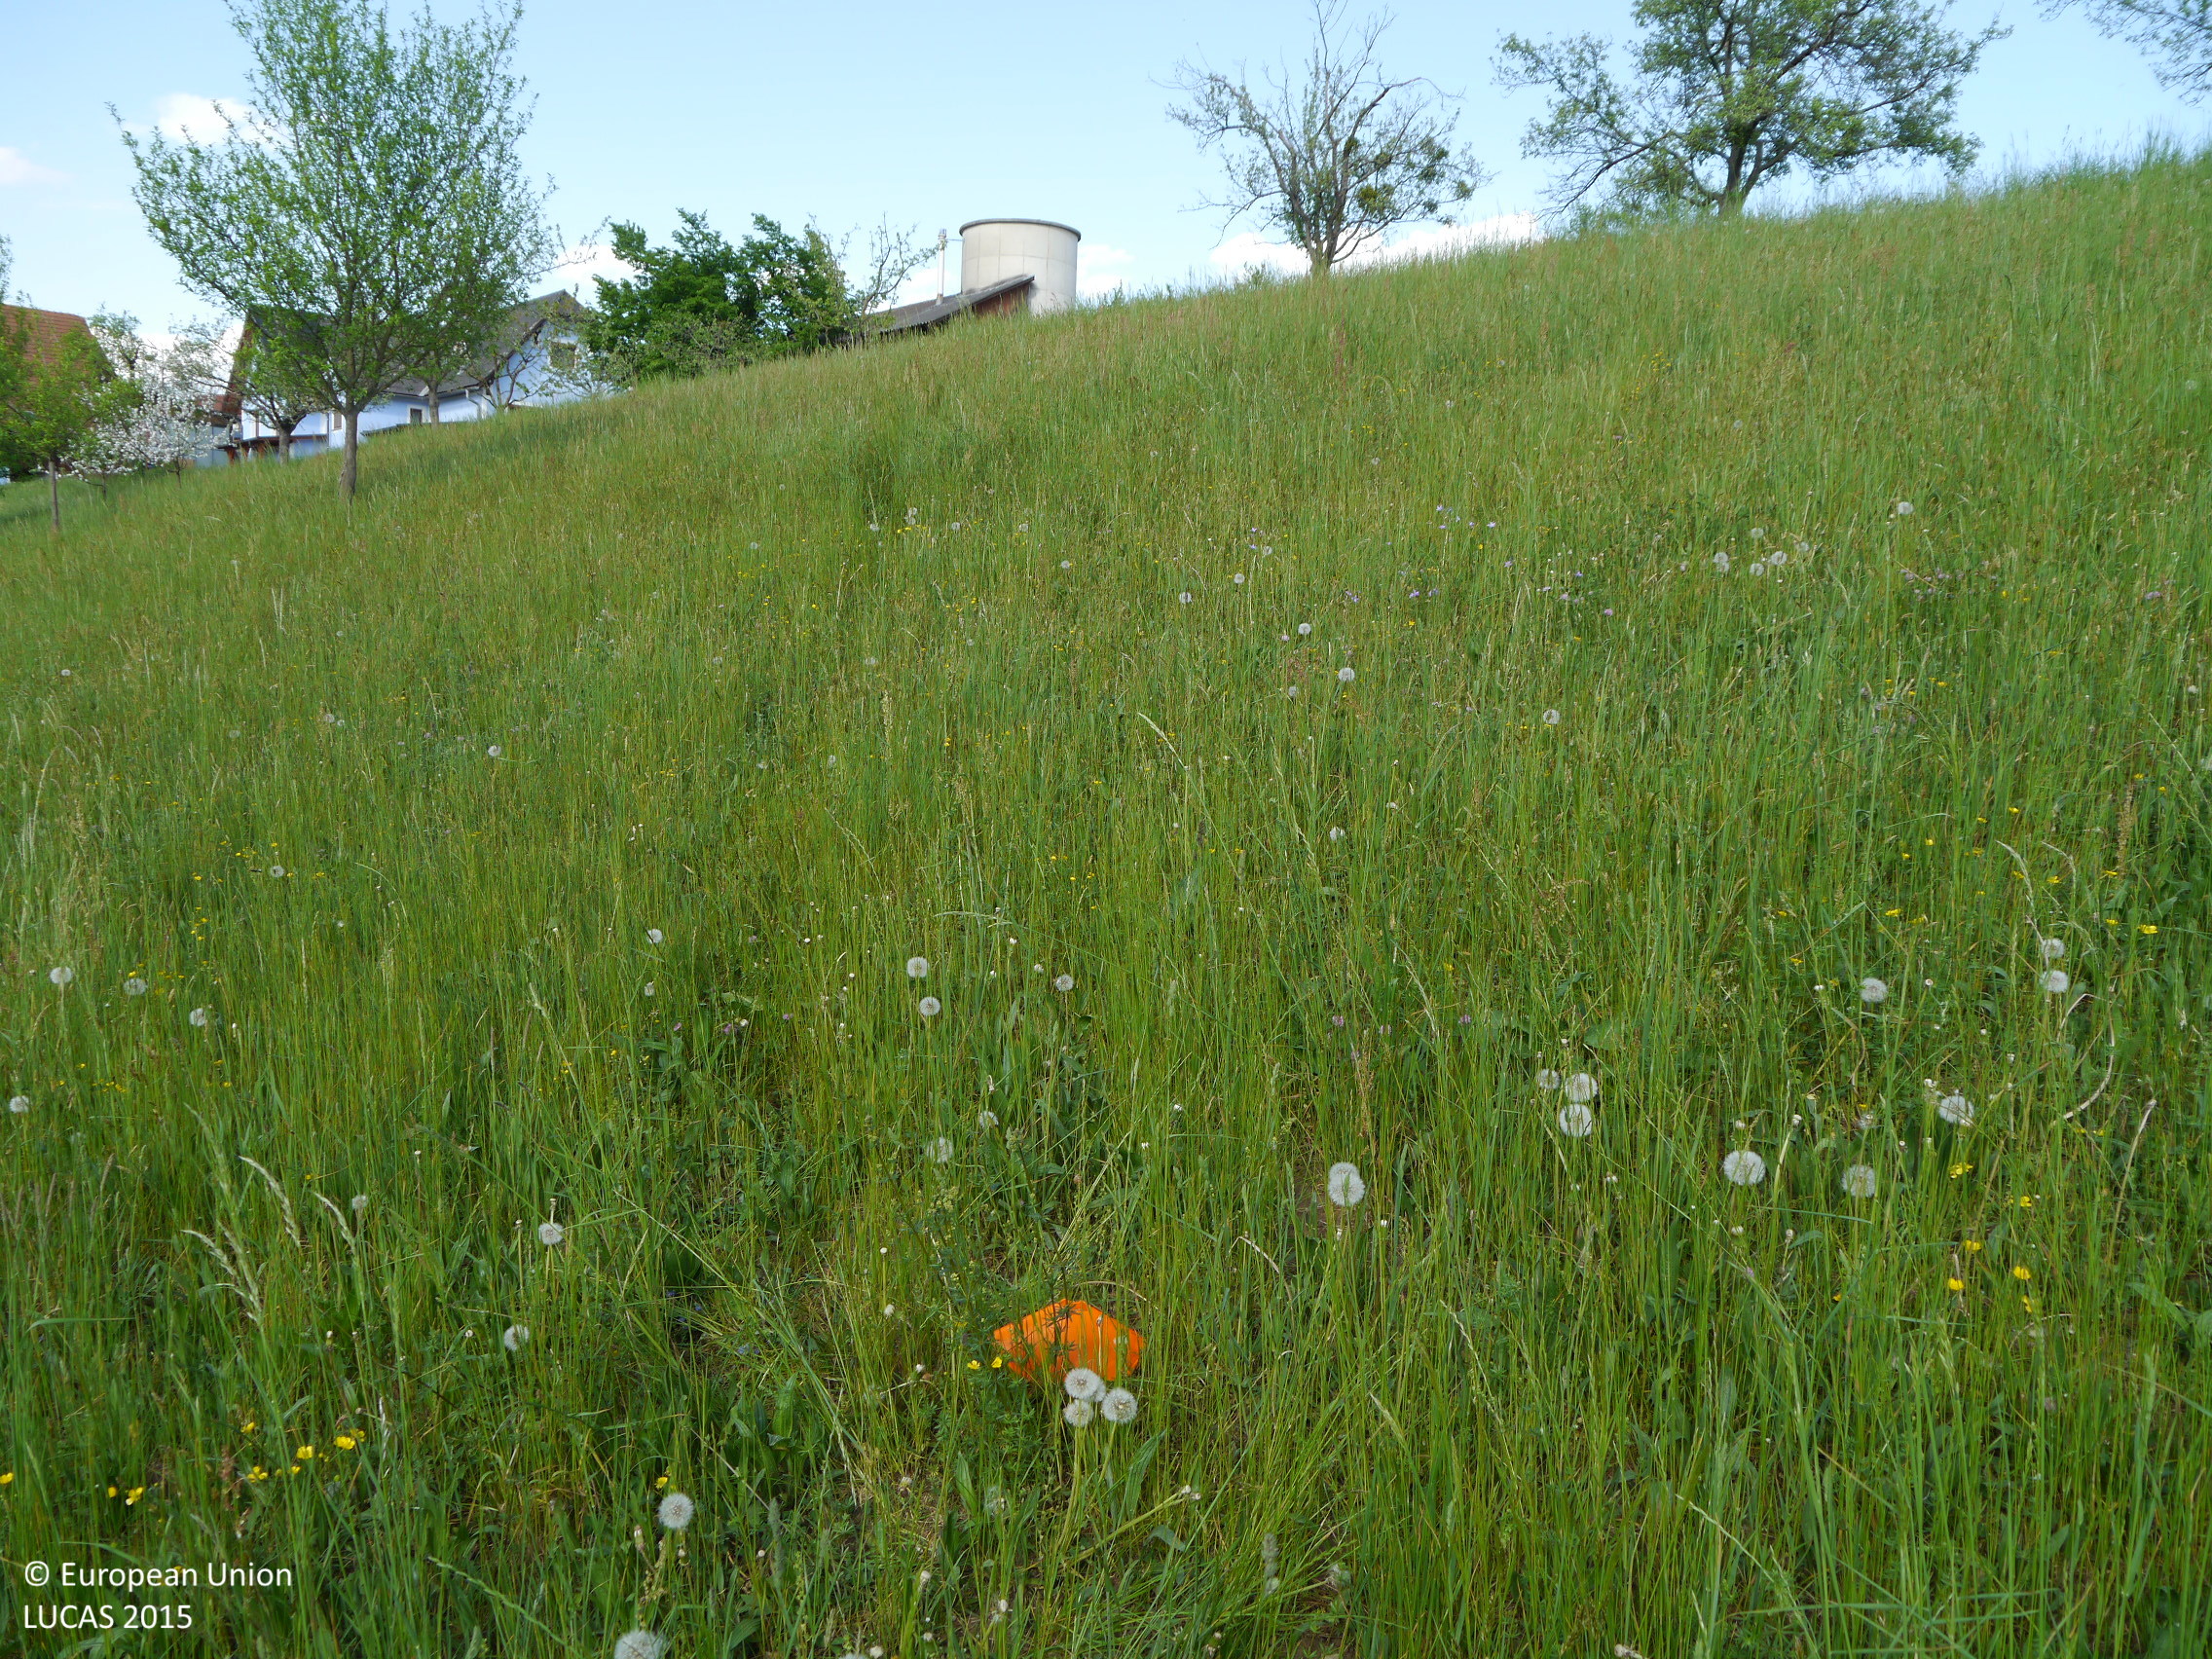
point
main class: Cropland
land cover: Apple fruit
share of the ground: 50 - 75 %
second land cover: Grassland without tree/shrub cover
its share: > 75 %
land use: Agriculture (excluding fallow land and kitchen gardens)
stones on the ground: < 10 %
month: May
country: AT
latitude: 47.0690
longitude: 15.2799
